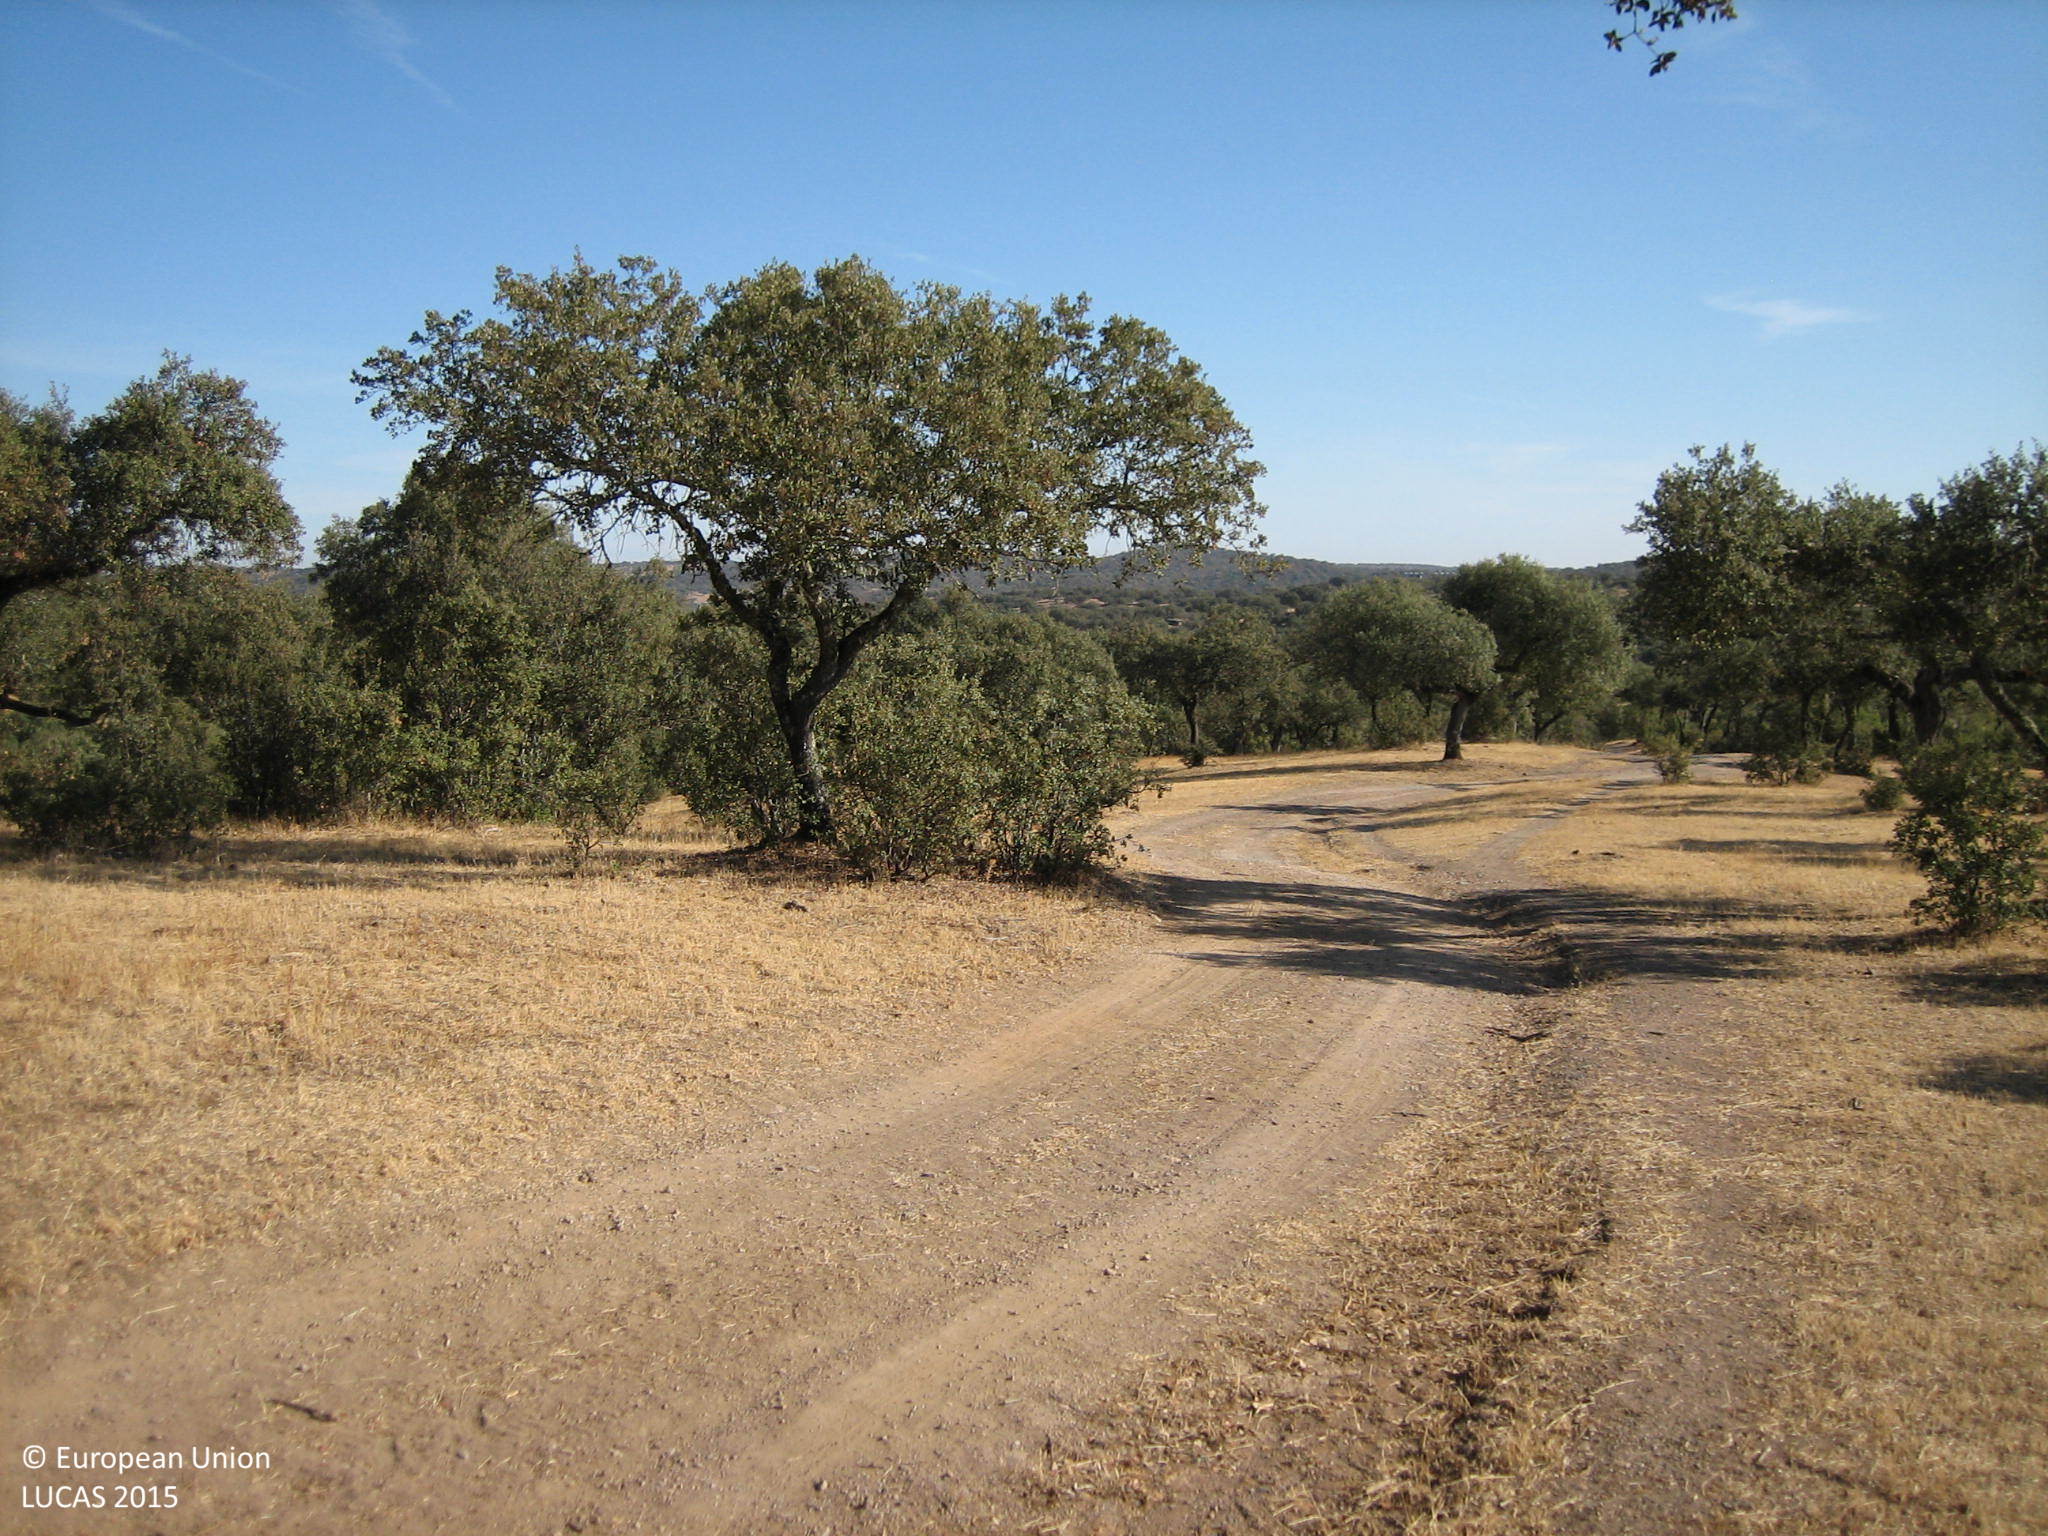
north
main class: Woodland
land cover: Broadleaved woodland
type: broadleaved evergreen forest
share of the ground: 10 - 25 %
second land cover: Grassland without tree/shrub cover
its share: > 75 %
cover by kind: herbaceous plants 80 %, broadleaved forest trees 10 %, unconsolidated bare surface 10 %
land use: Forestry
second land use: Agriculture (excluding fallow land and kitchen gardens)
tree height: < 5 m
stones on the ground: < 10 %
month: August
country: ES
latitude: 38.5427
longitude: -7.2449
